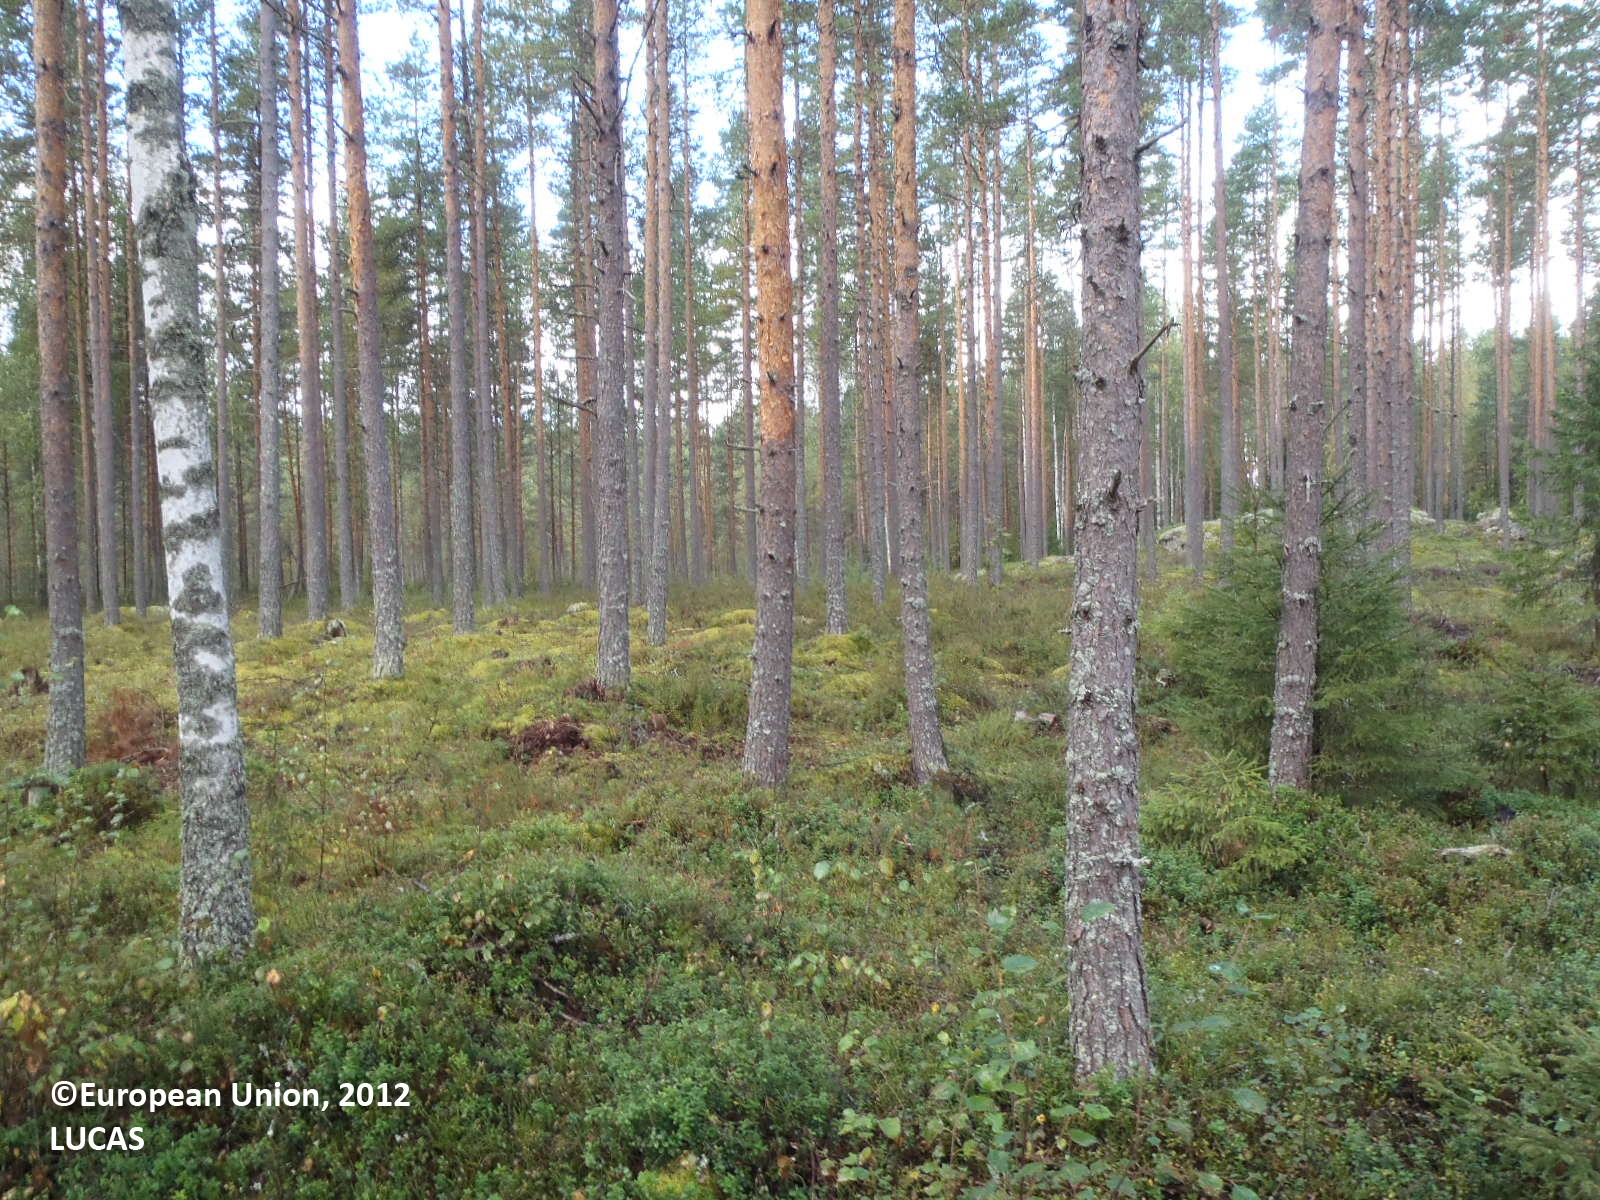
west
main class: Woodland
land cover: Pine dominated coniferous woodland
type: boreal forest
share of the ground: > 75 %
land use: Forestry
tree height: > 5 m
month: September
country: FI
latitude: 61.7157
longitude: 22.7979
